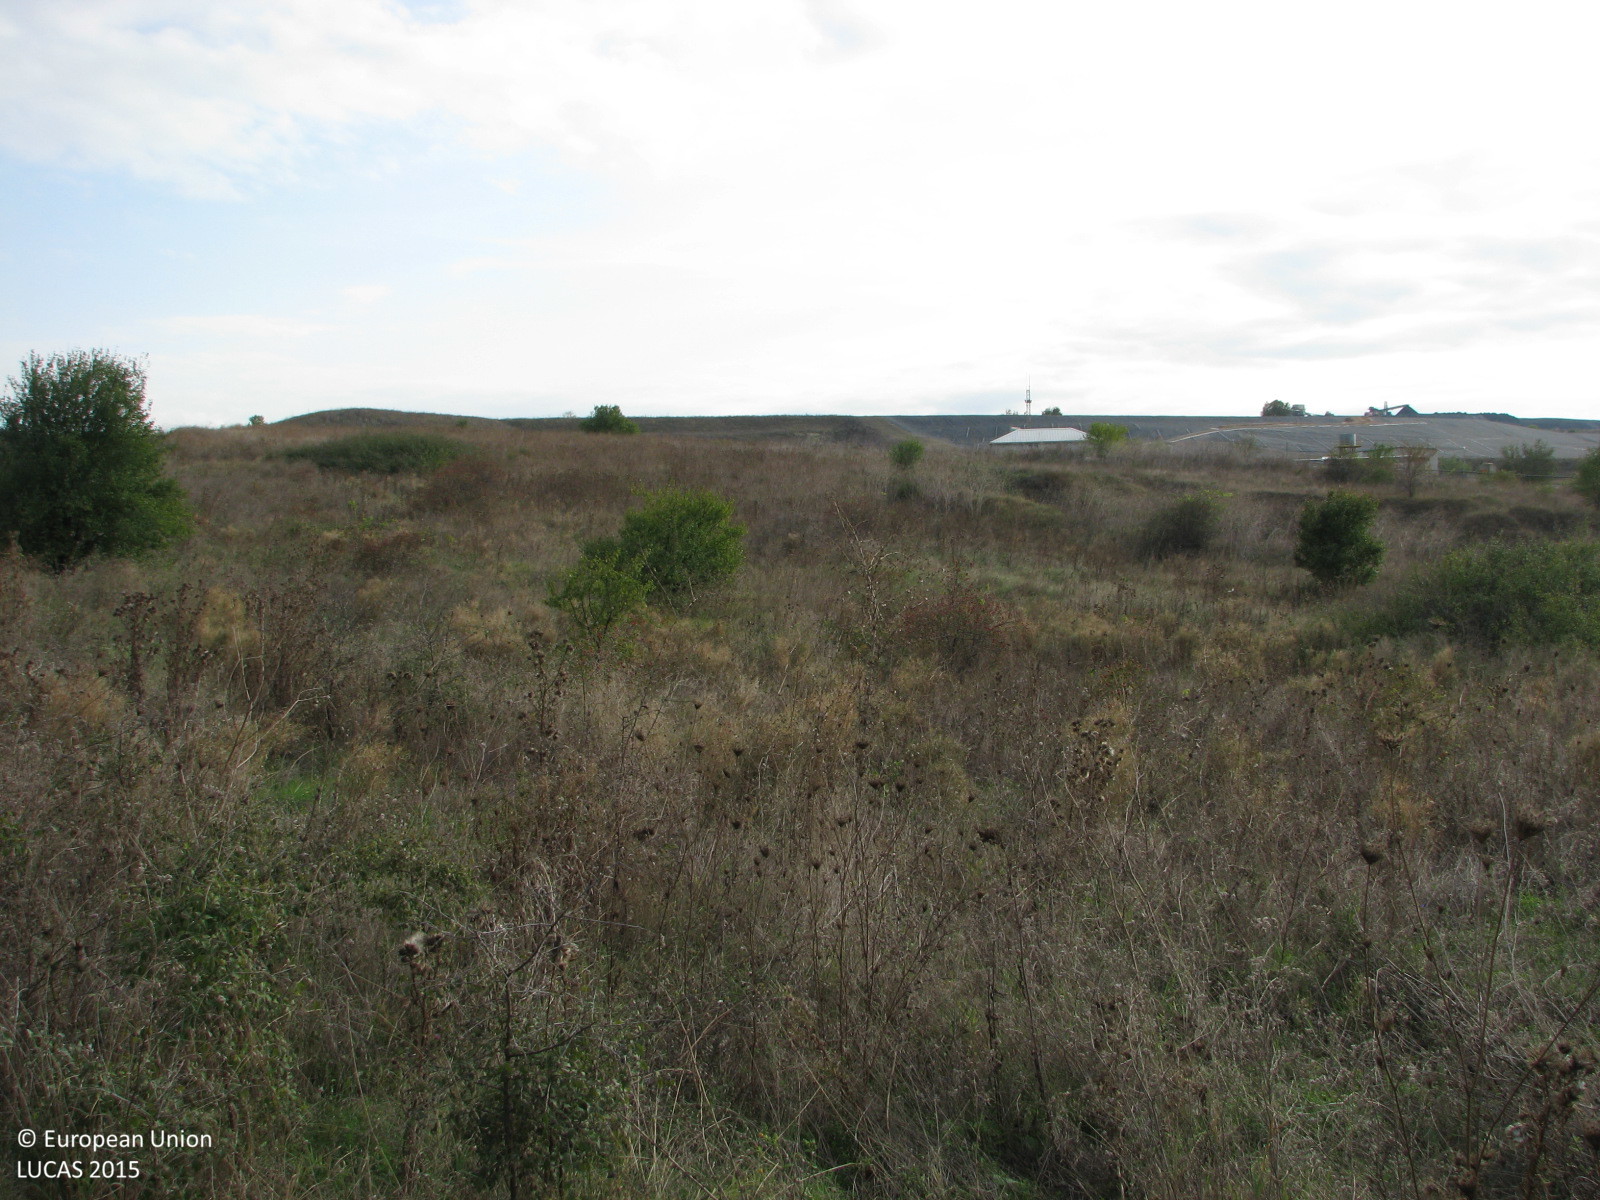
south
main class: Grassland
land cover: Grassland without tree/shrub cover
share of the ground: > 75 %
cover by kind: herbaceous plants 95 %, shrubs 5 %
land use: Agriculture (excluding fallow land and kitchen gardens)
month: October
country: BG
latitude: 42.2326
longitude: 26.1355
